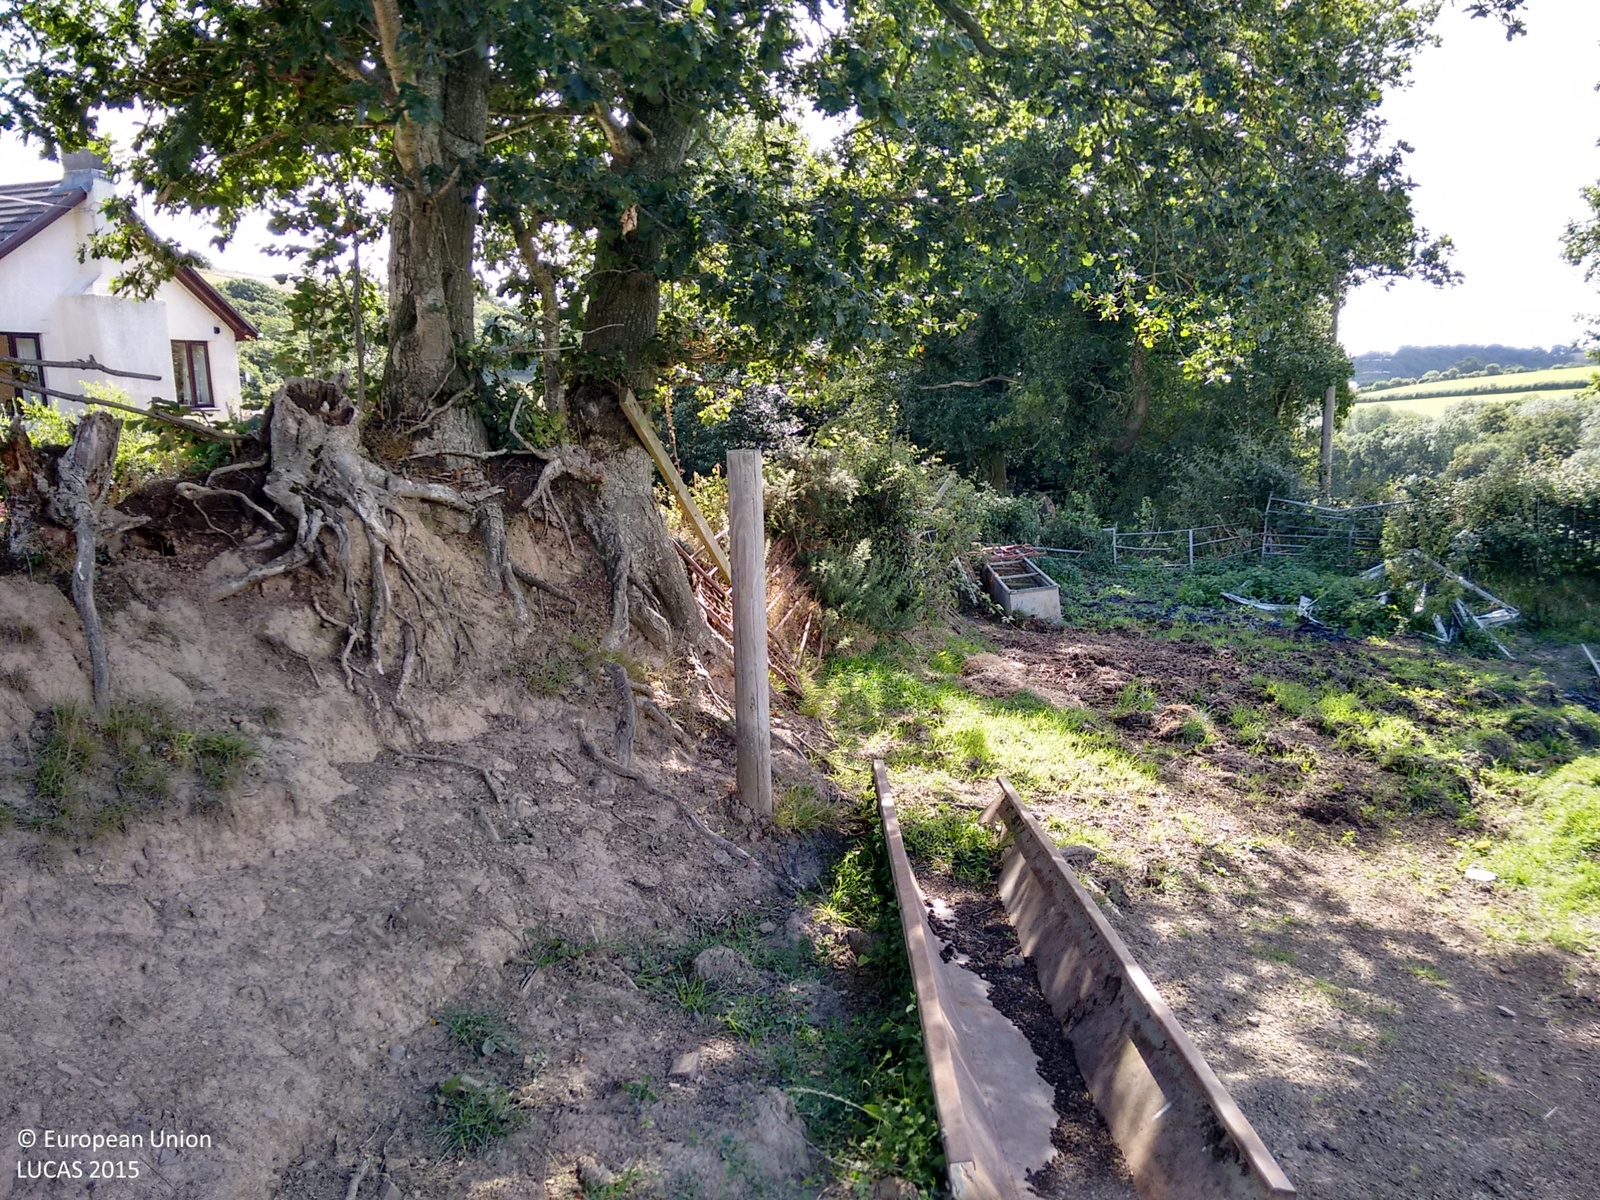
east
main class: Grassland
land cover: Grassland without tree/shrub cover
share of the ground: > 75 %
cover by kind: herbaceous plants 100 %
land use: Agriculture (excluding fallow land and kitchen gardens)
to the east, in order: Grassland without tree/shrub cover; Fences; Managed hedges; Paved roads, cycling and walking lanes; Managed hedges; Electric lines; Managed hedges; Electric lines; Managed hedges; Tracks; Broadleaved woodland; Fences; Broadleaved woodland; Tracks; Grassland without tree/shrub cover; Broadleaved woodland; Electric lines; Broadleaved woodland; Fences; Broadleaved woodland; Paved roads, cycling and walking lanes; Managed hedges; Grassland without tree/shrub cover
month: August
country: GB
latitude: 50.7339
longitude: -3.5884
